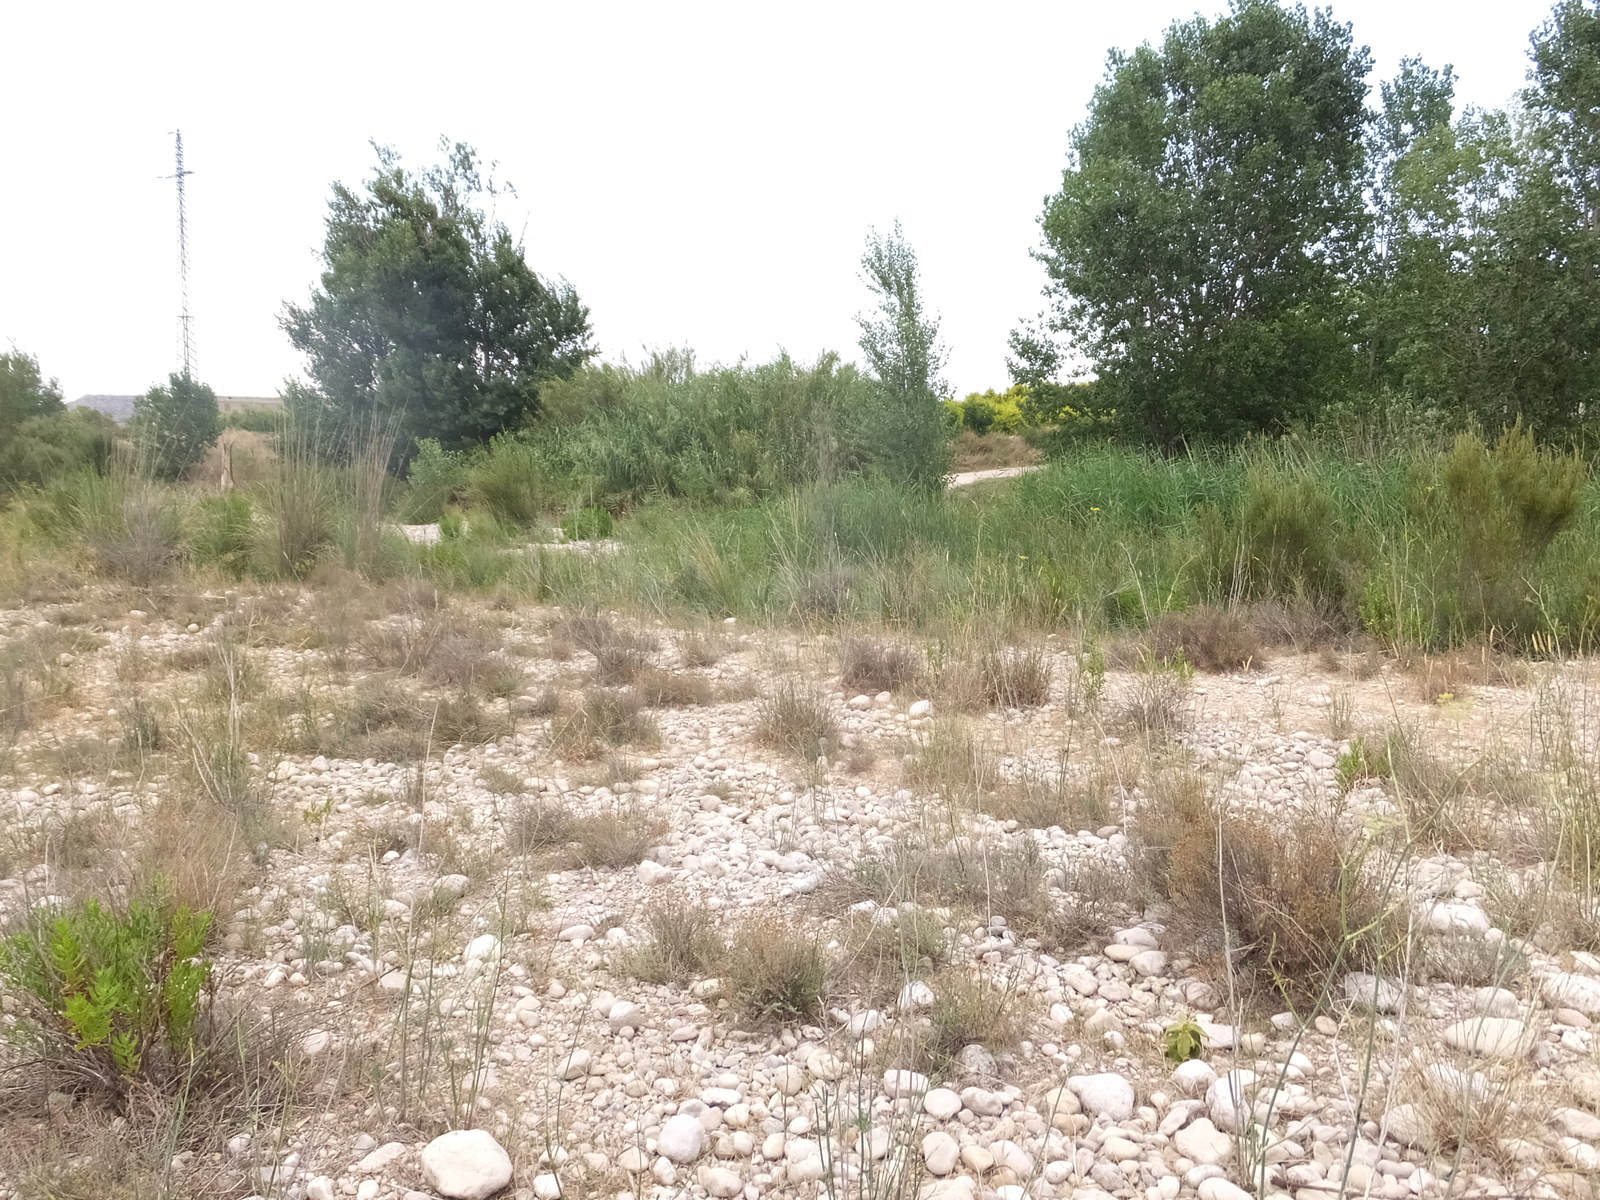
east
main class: Shrubland
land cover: Shrubland with sparse tree cover
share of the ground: > 75 %
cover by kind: shrubs 70 %, herbaceous plants 25 %, broadleaved forest trees 5 %
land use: Semi-natural and natural areas not in use
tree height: > 5 m
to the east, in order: Shrubland with sparse tree cover; Rivers and streams; Shrubland with sparse tree cover; Tracks; Shruby margins; Other fruit trees and berries; Shruby margins; Other fruit trees and berries; Shruby margins; Tracks; Shruby margins; Other fruit trees and berries; Shruby margins; Other fruit trees and berries; Shruby margins; Pear fruit; Shruby margins; Dry stone walls; Shruby margins; Pear fruit
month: July
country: ES
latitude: 41.1169
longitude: 0.1403
